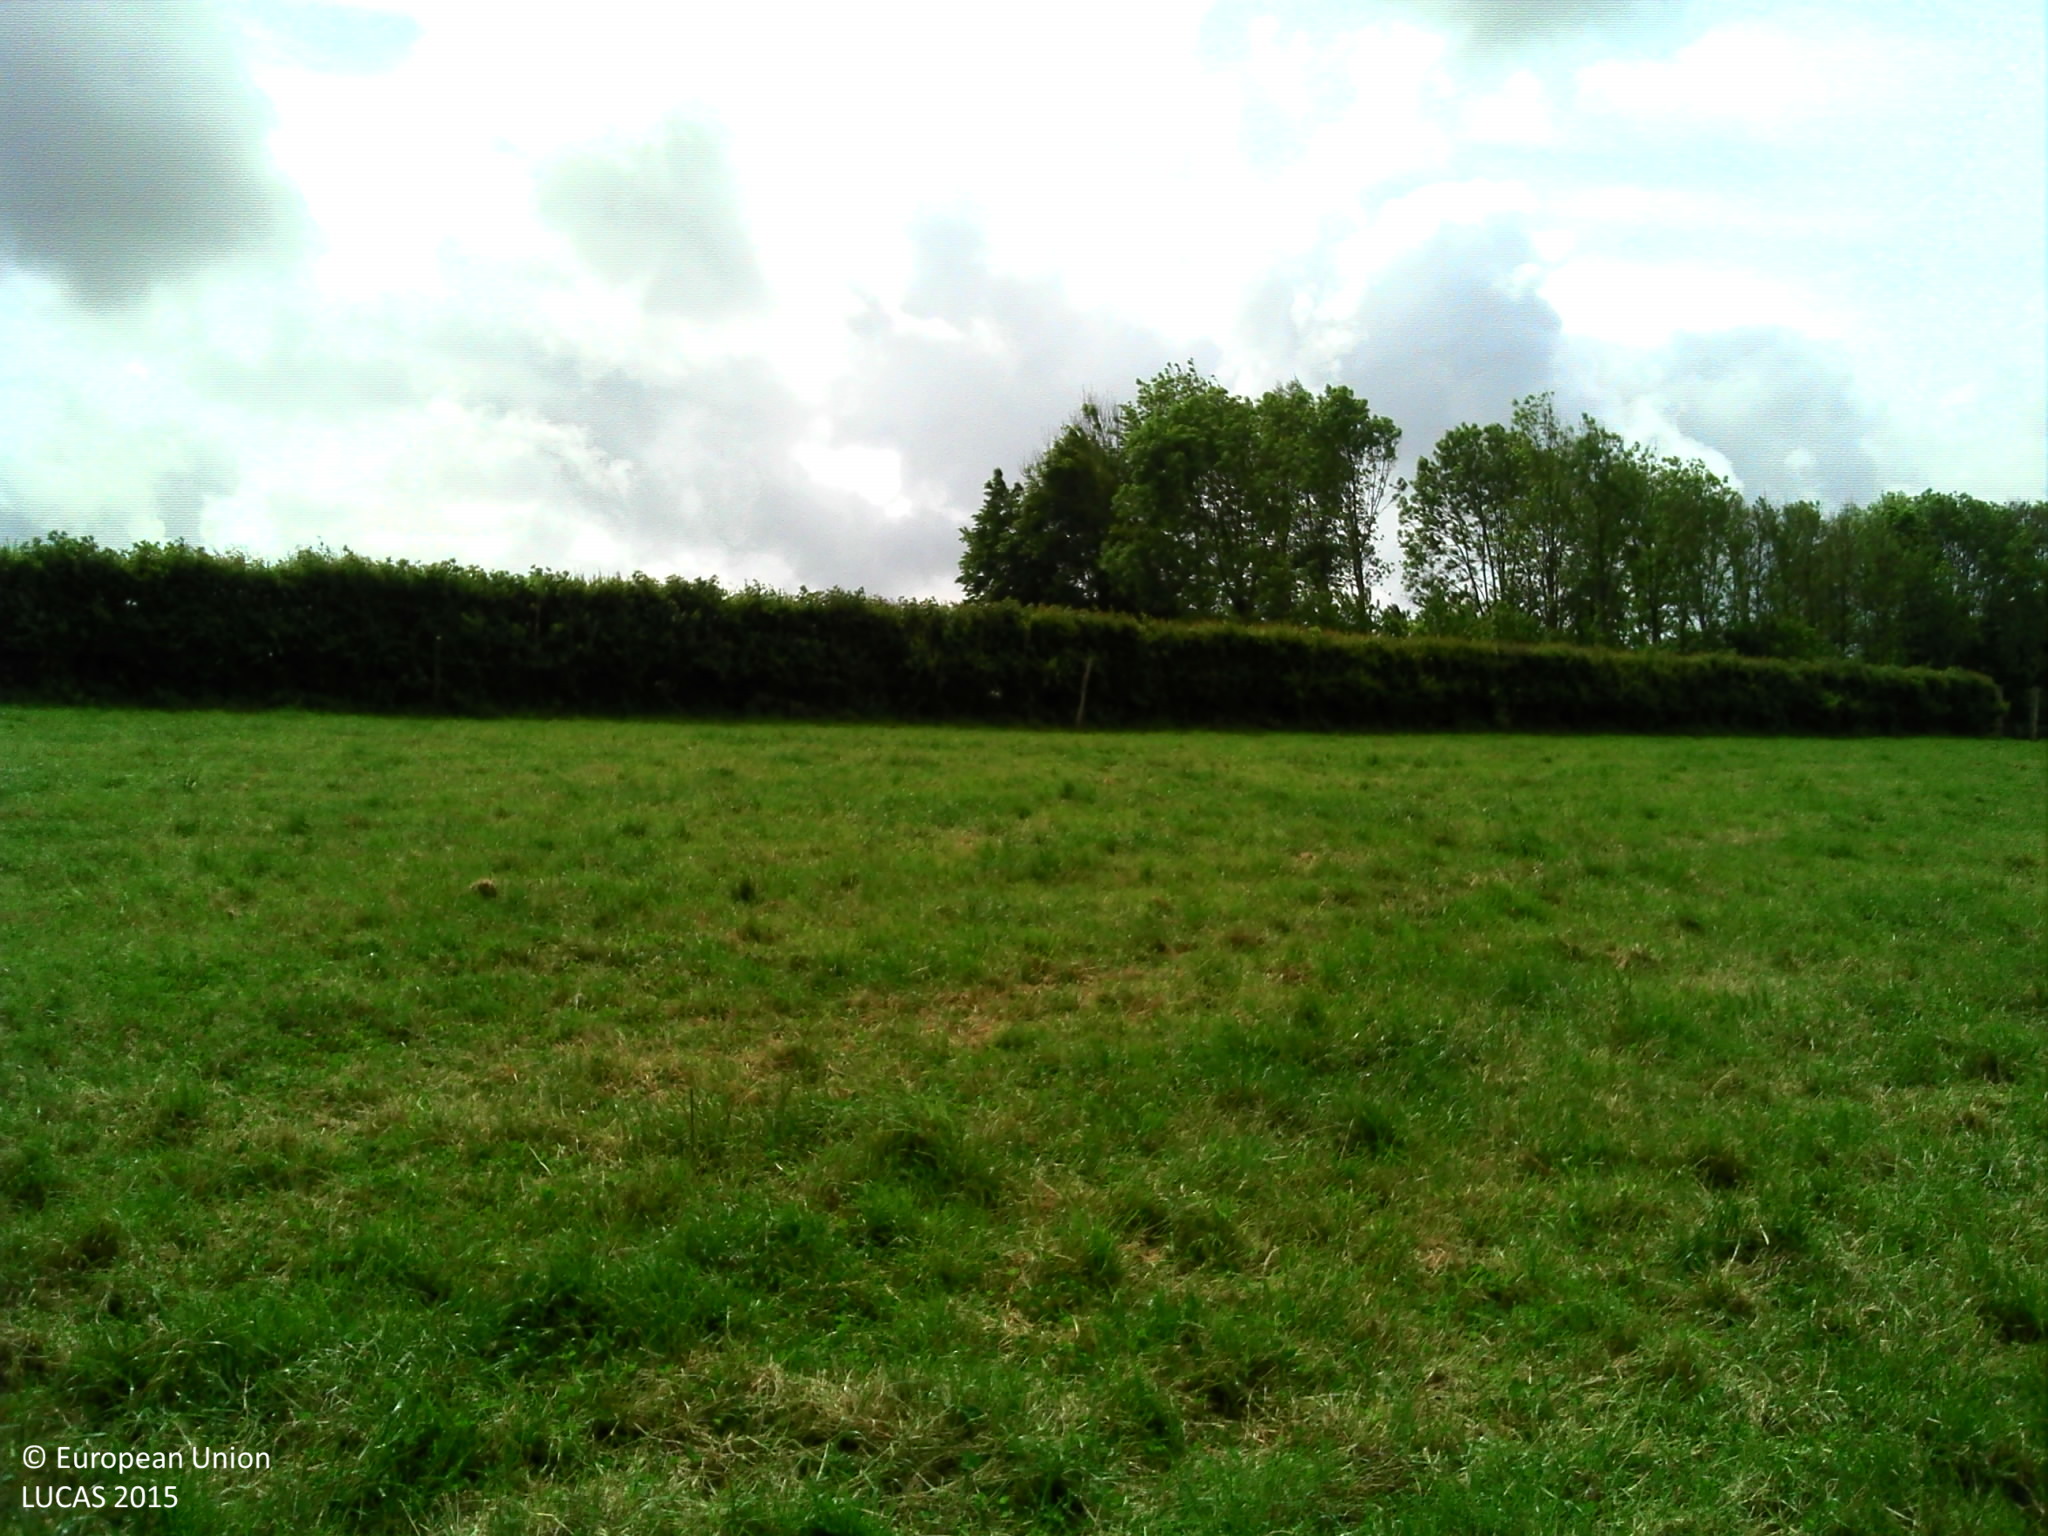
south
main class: Grassland
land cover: Grassland with sparse tree/shrub cover
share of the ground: > 75 %
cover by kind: herbaceous plants 95 %, broadleaved forest trees 5 %
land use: Agriculture (excluding fallow land and kitchen gardens)
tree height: < 5 m
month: May
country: FR
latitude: 50.6352
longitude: 2.1381
